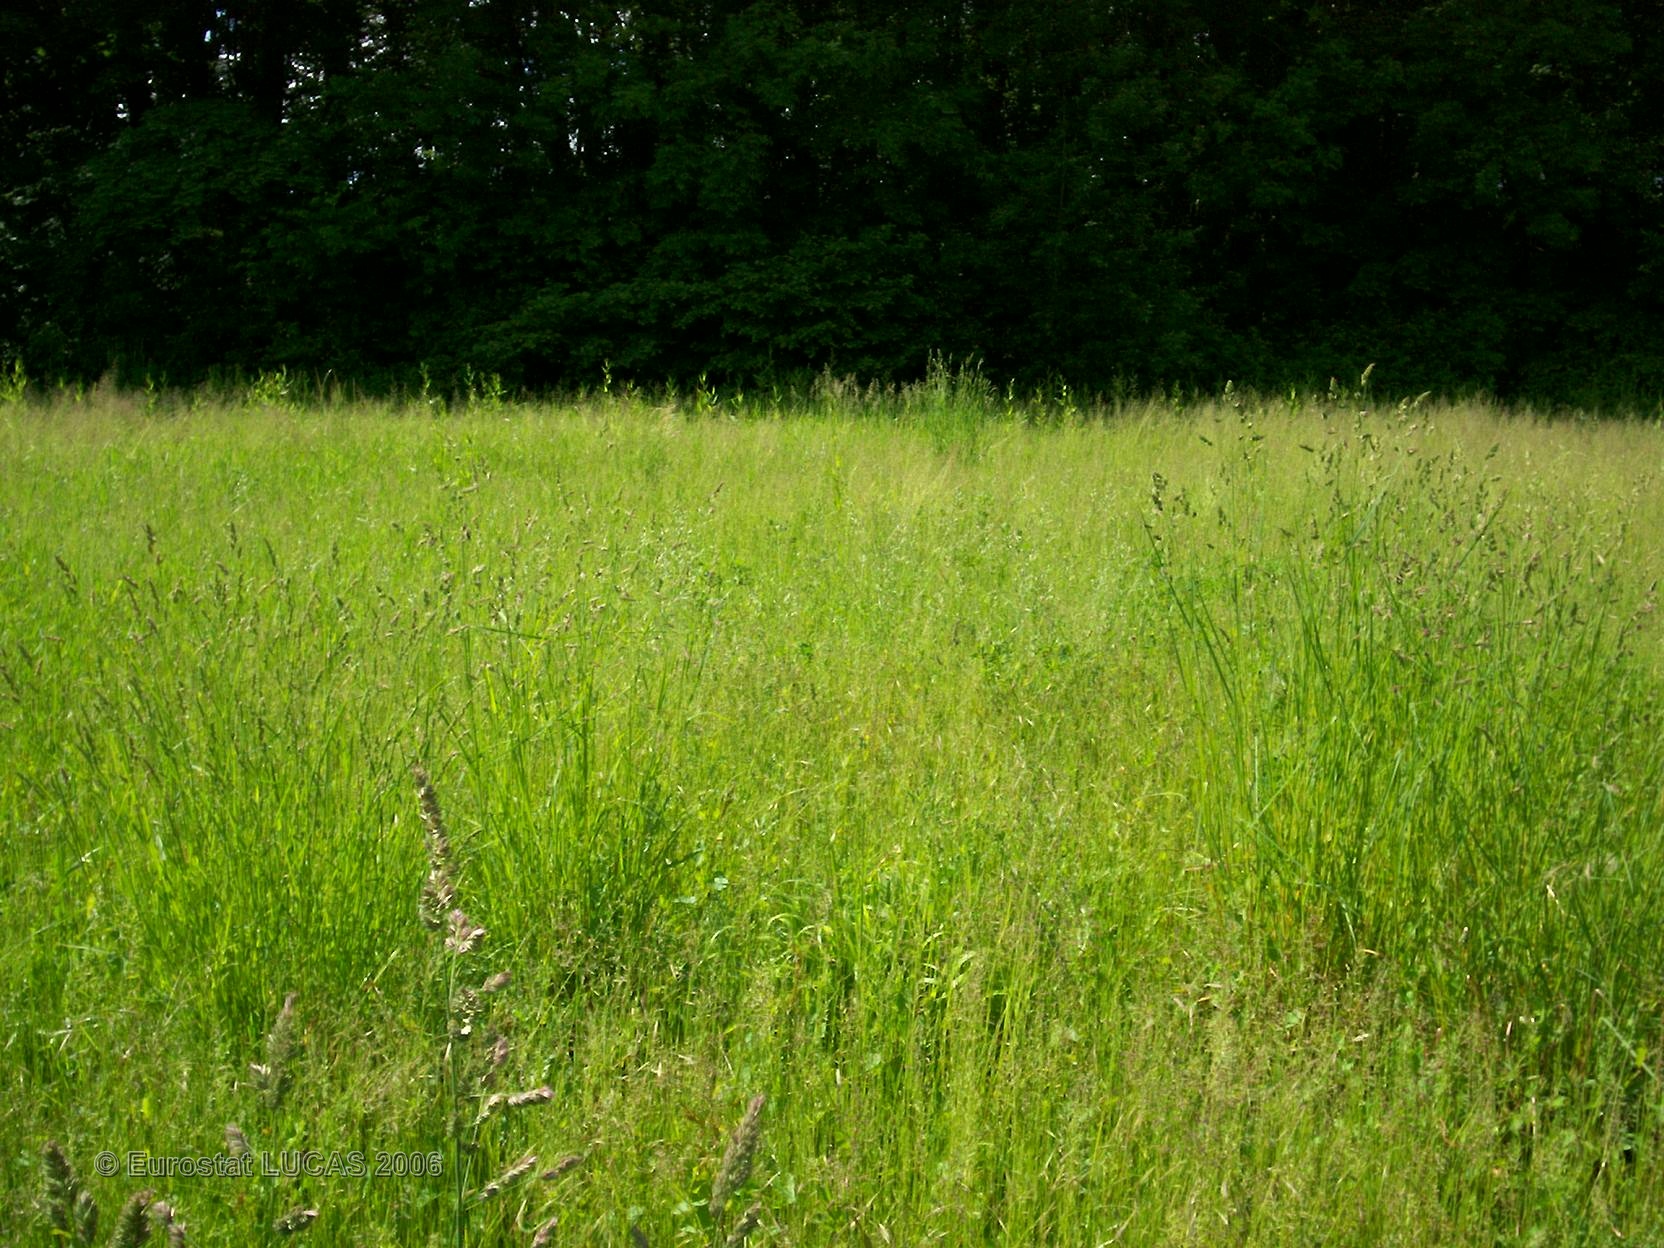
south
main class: Grassland
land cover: Grassland without tree/shrub cover
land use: Agriculture (excluding fallow land and kitchen gardens)
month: May
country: FR
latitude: 48.4261
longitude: 4.4429
